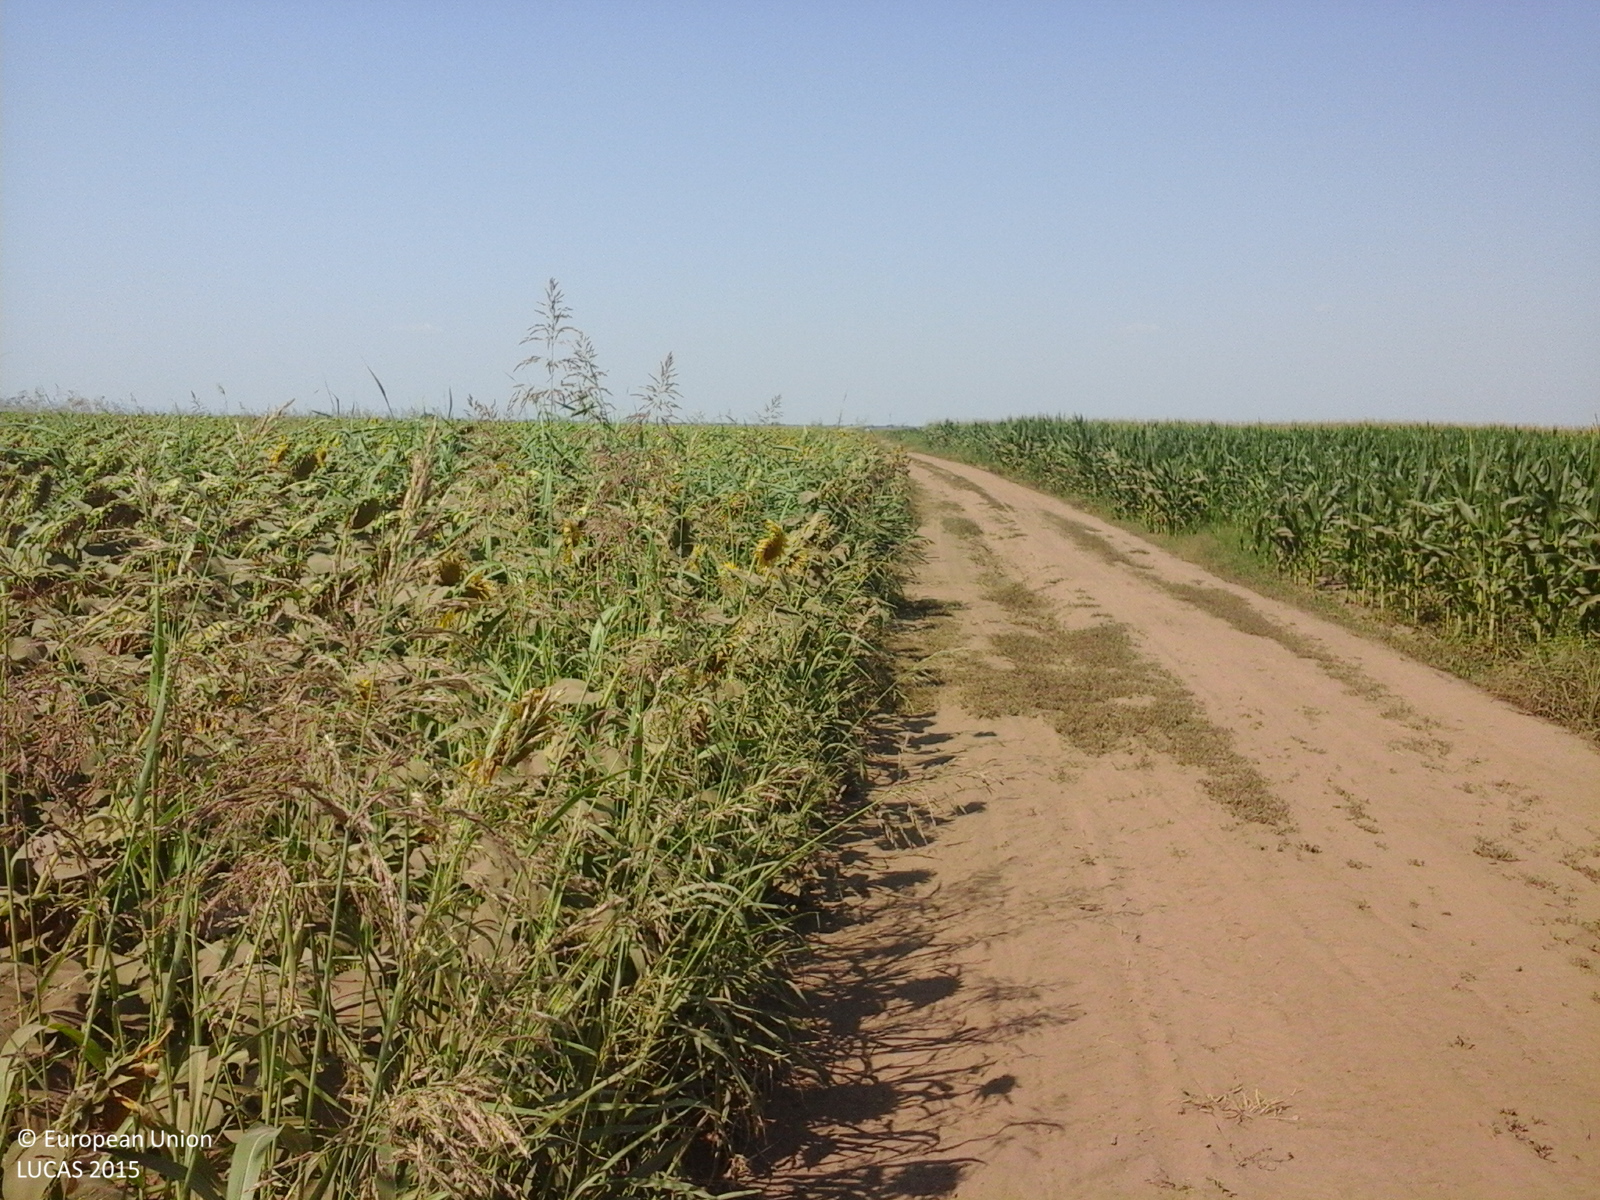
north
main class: Cropland
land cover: Maize
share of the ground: > 75 %
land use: Agriculture (excluding fallow land and kitchen gardens)
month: July
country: RO
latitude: 45.0443
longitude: 26.9290
